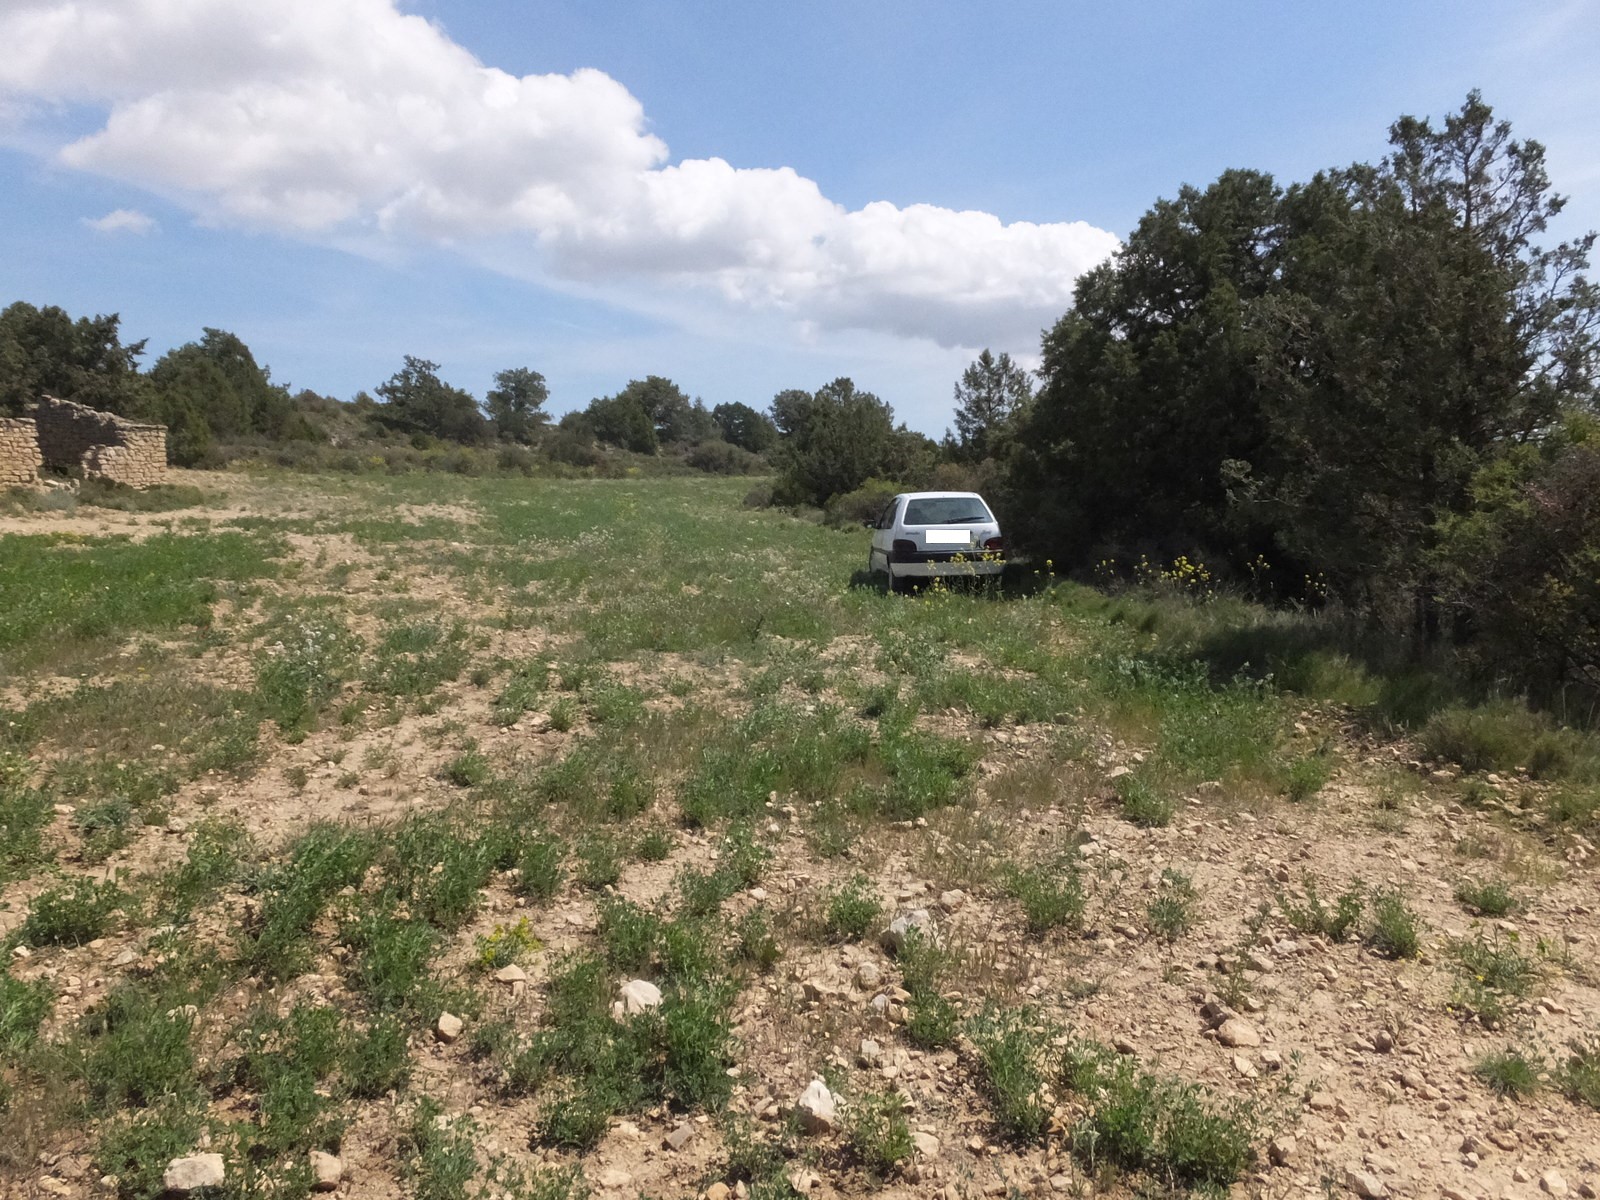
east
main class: Cropland
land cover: Lucerne
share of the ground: > 75 %
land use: Agriculture (excluding fallow land and kitchen gardens)
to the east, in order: Lucerne; Broadleaved woodland; Lucerne; Broadleaved woodland; Tracks; Barley
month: April
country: ES
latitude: 41.6511
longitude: -0.3323
